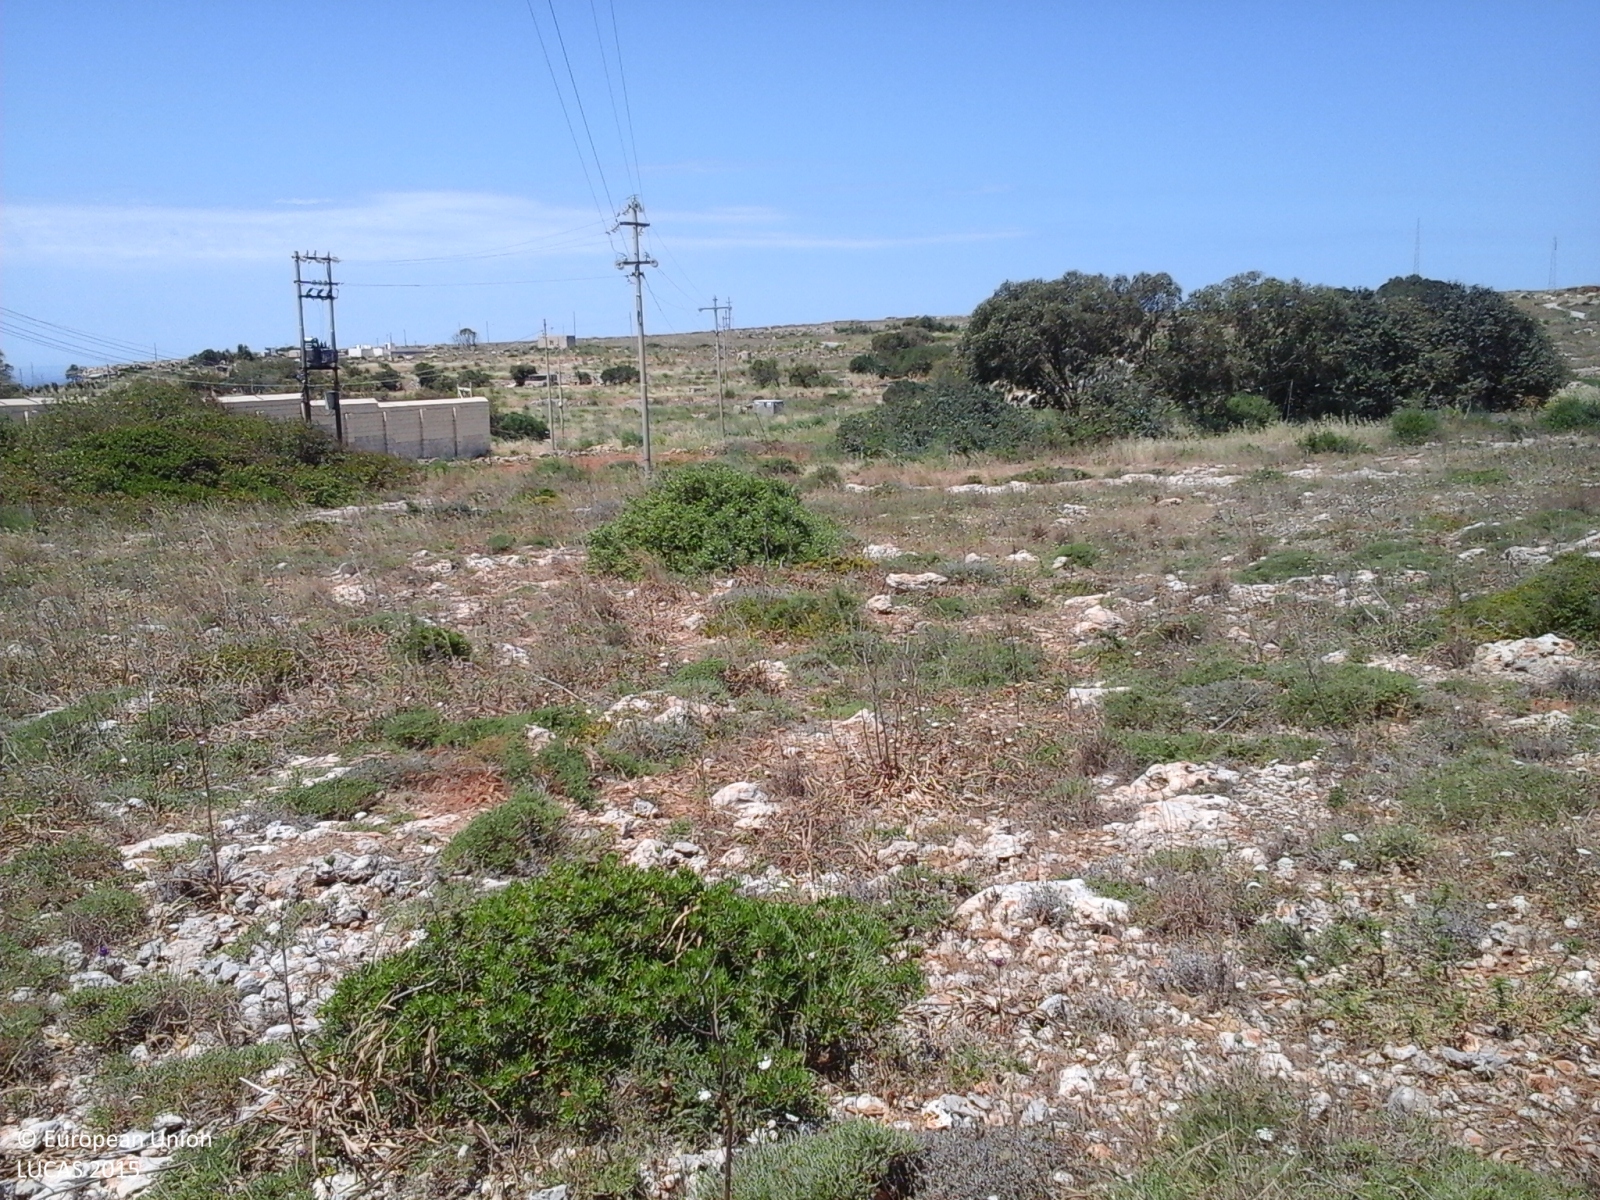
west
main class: Shrubland
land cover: Shrubland without tree cover
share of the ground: > 75 %
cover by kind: shrubs 50 %, herbaceous plants 30 %, consolidated bare surface 20 %
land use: Semi-natural and natural areas not in use
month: May
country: MT
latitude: 35.8826
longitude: 14.3571
